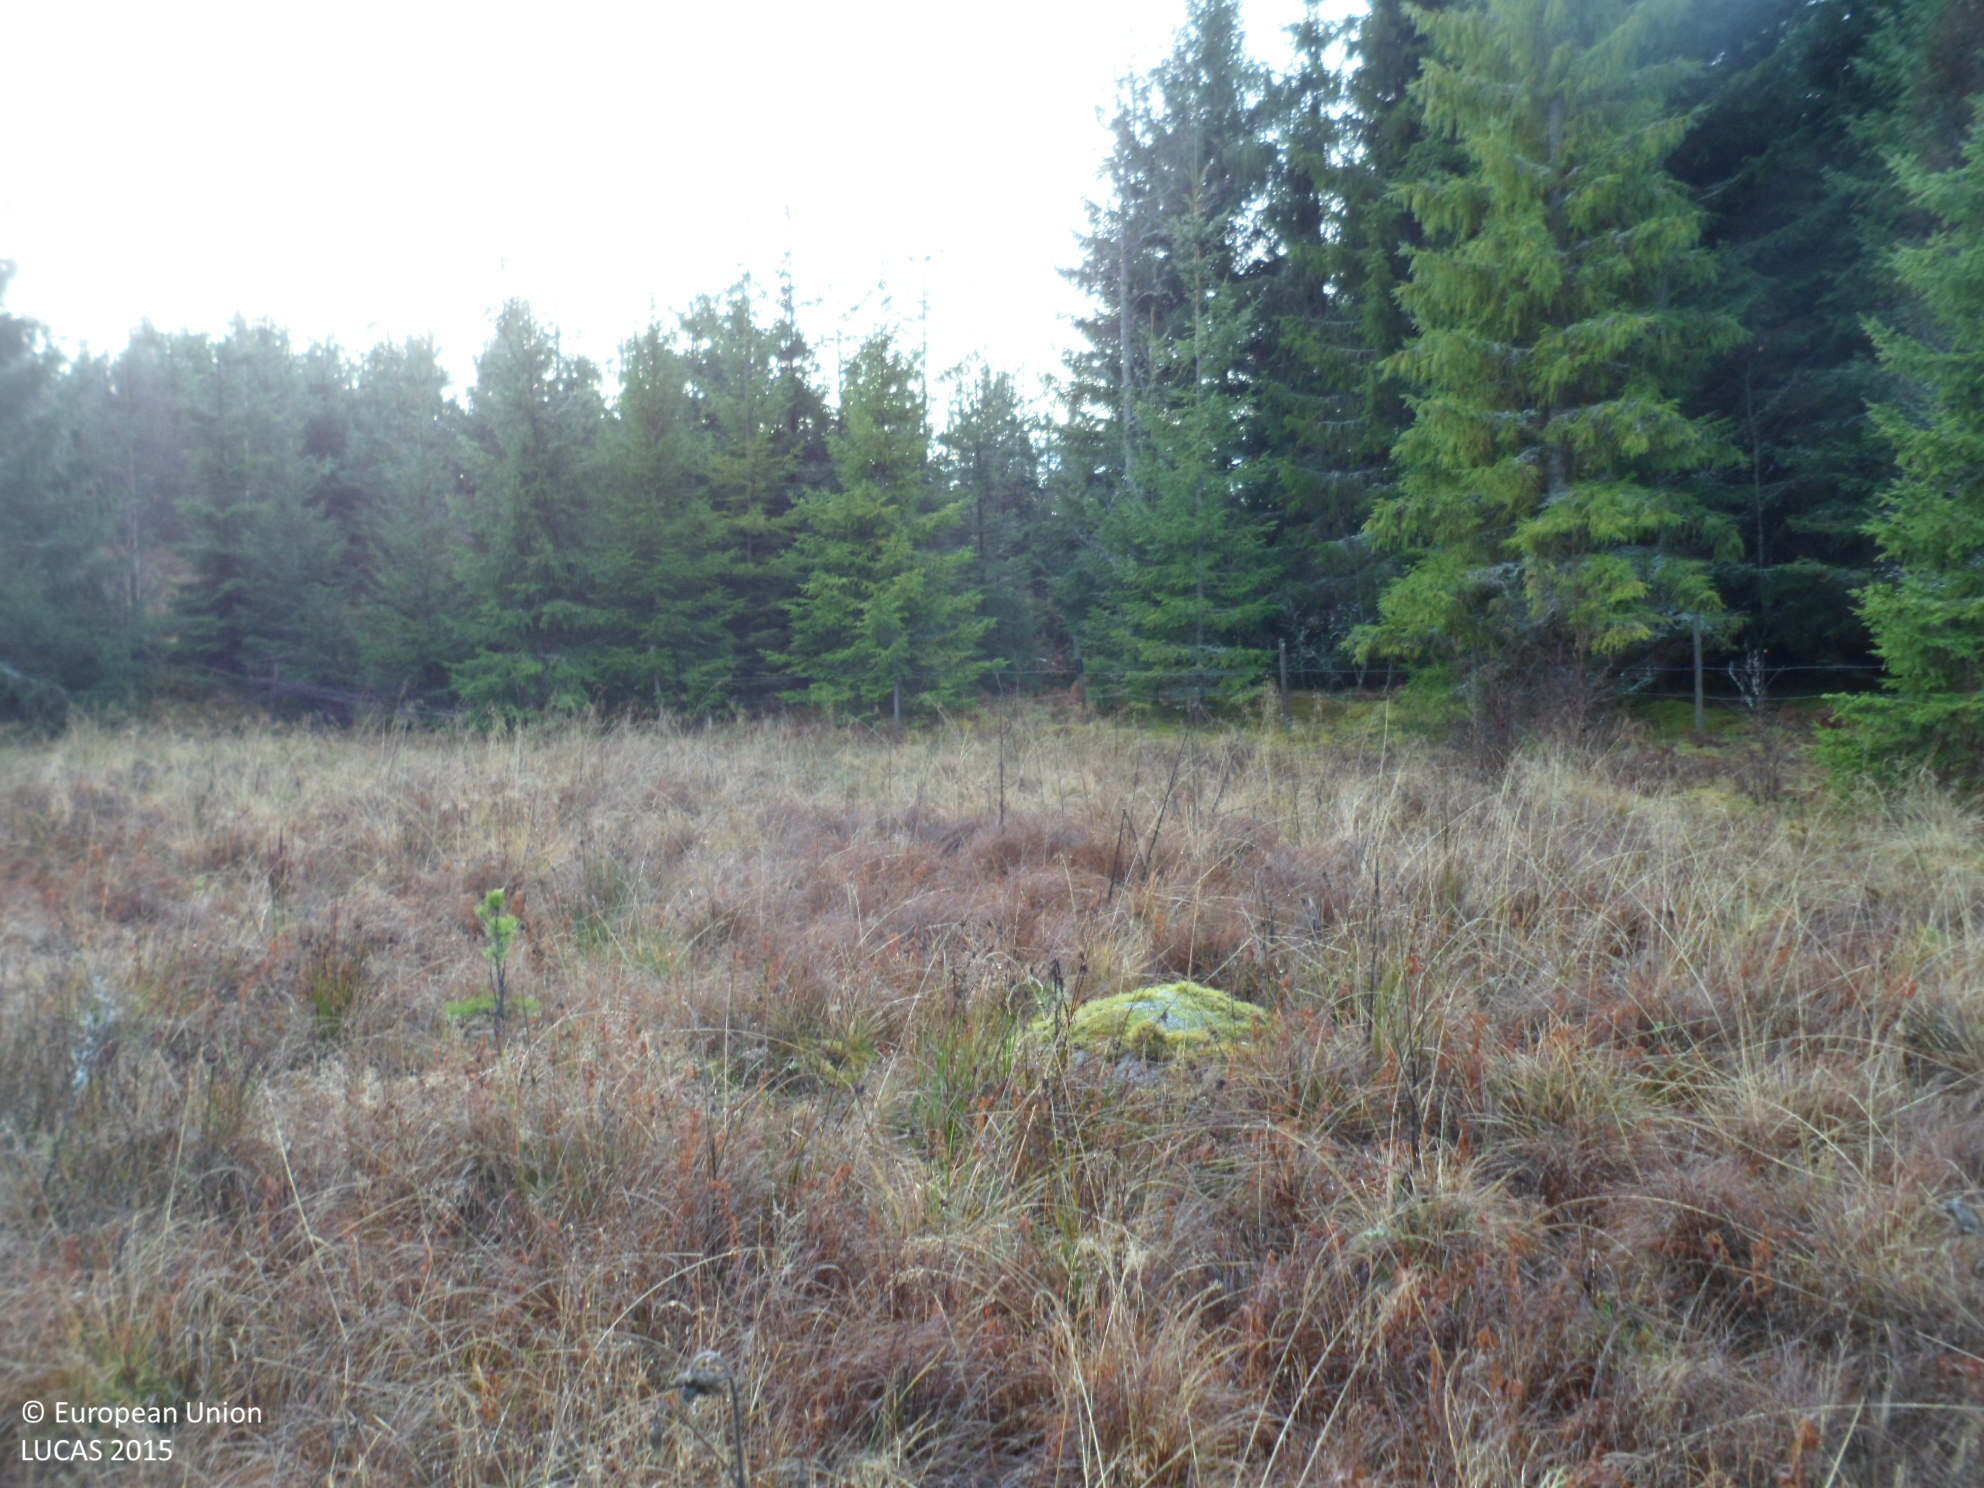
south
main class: Grassland
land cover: Grassland without tree/shrub cover
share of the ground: > 75 %
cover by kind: herbaceous plants 90 %, lichens and mosses 10 %
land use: Agriculture (excluding fallow land and kitchen gardens)
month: November
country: SE
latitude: 57.5461
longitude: 15.9625
